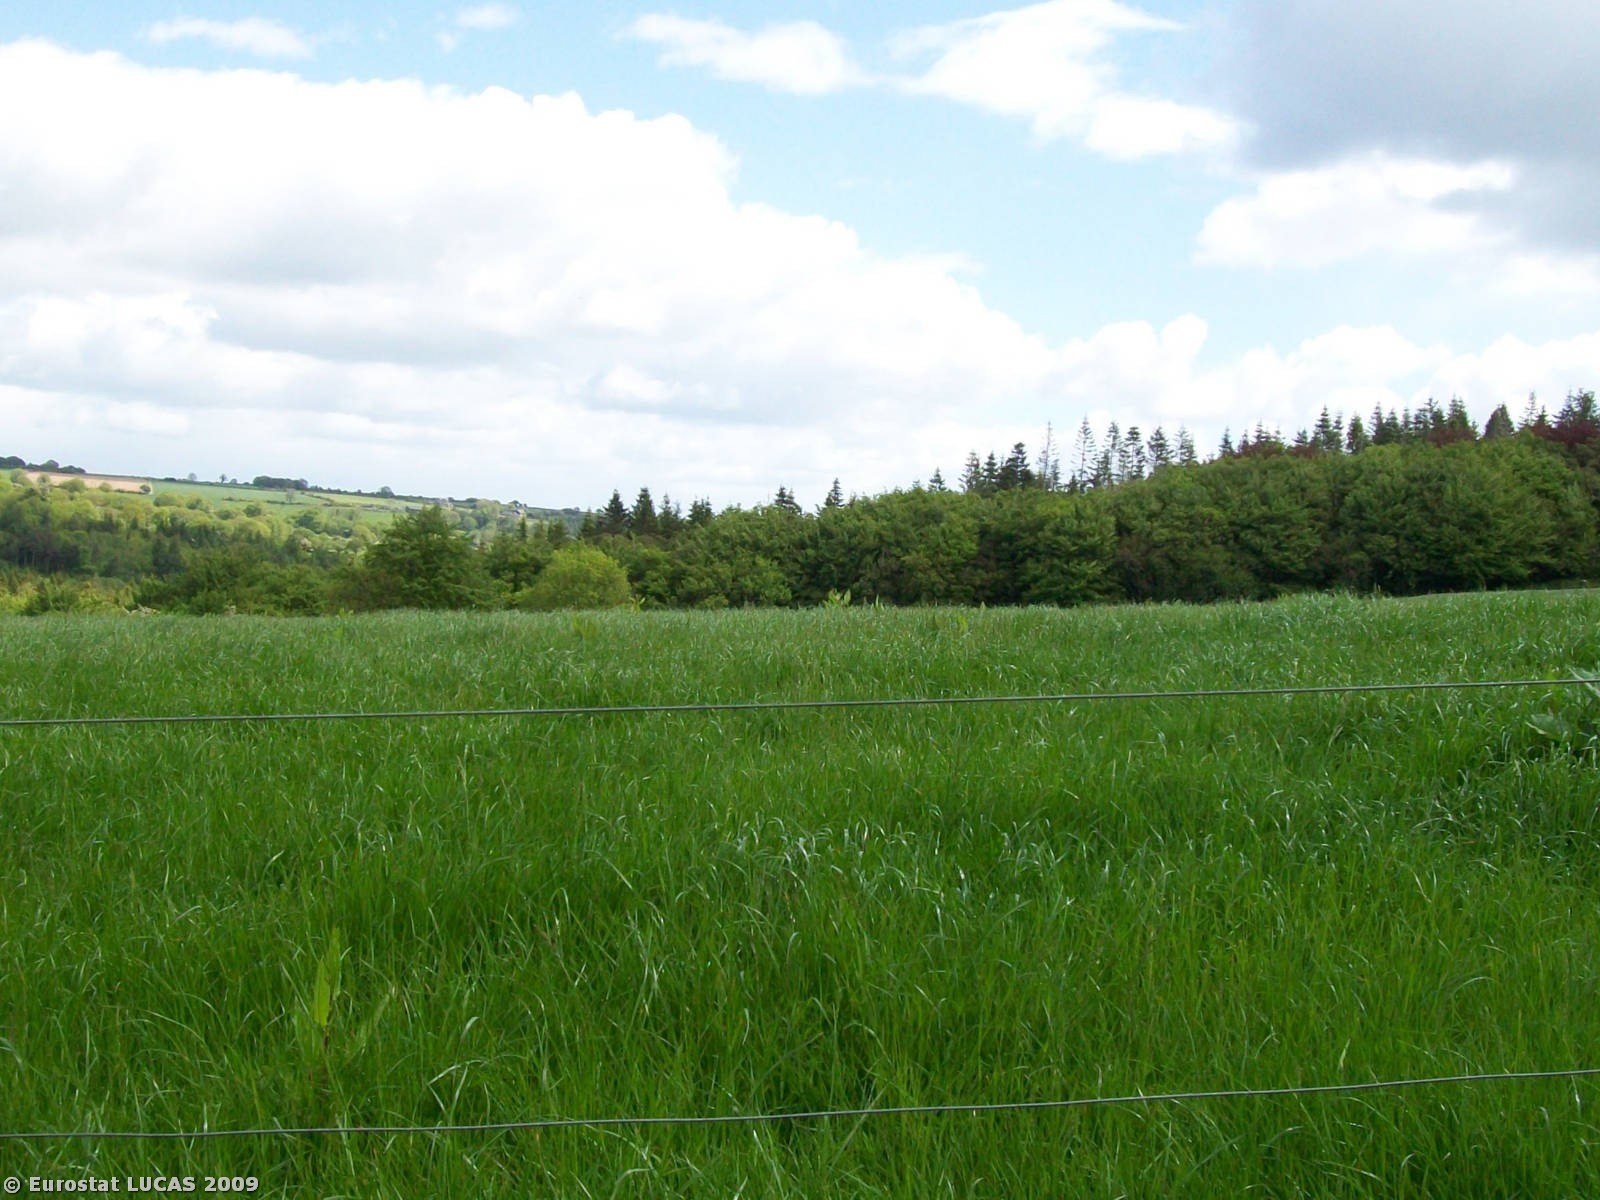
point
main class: Grassland
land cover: Grassland without tree/shrub cover
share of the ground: > 75 %
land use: Agriculture (excluding fallow land and kitchen gardens)
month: May
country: IE
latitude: 51.7837
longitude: -8.7735
